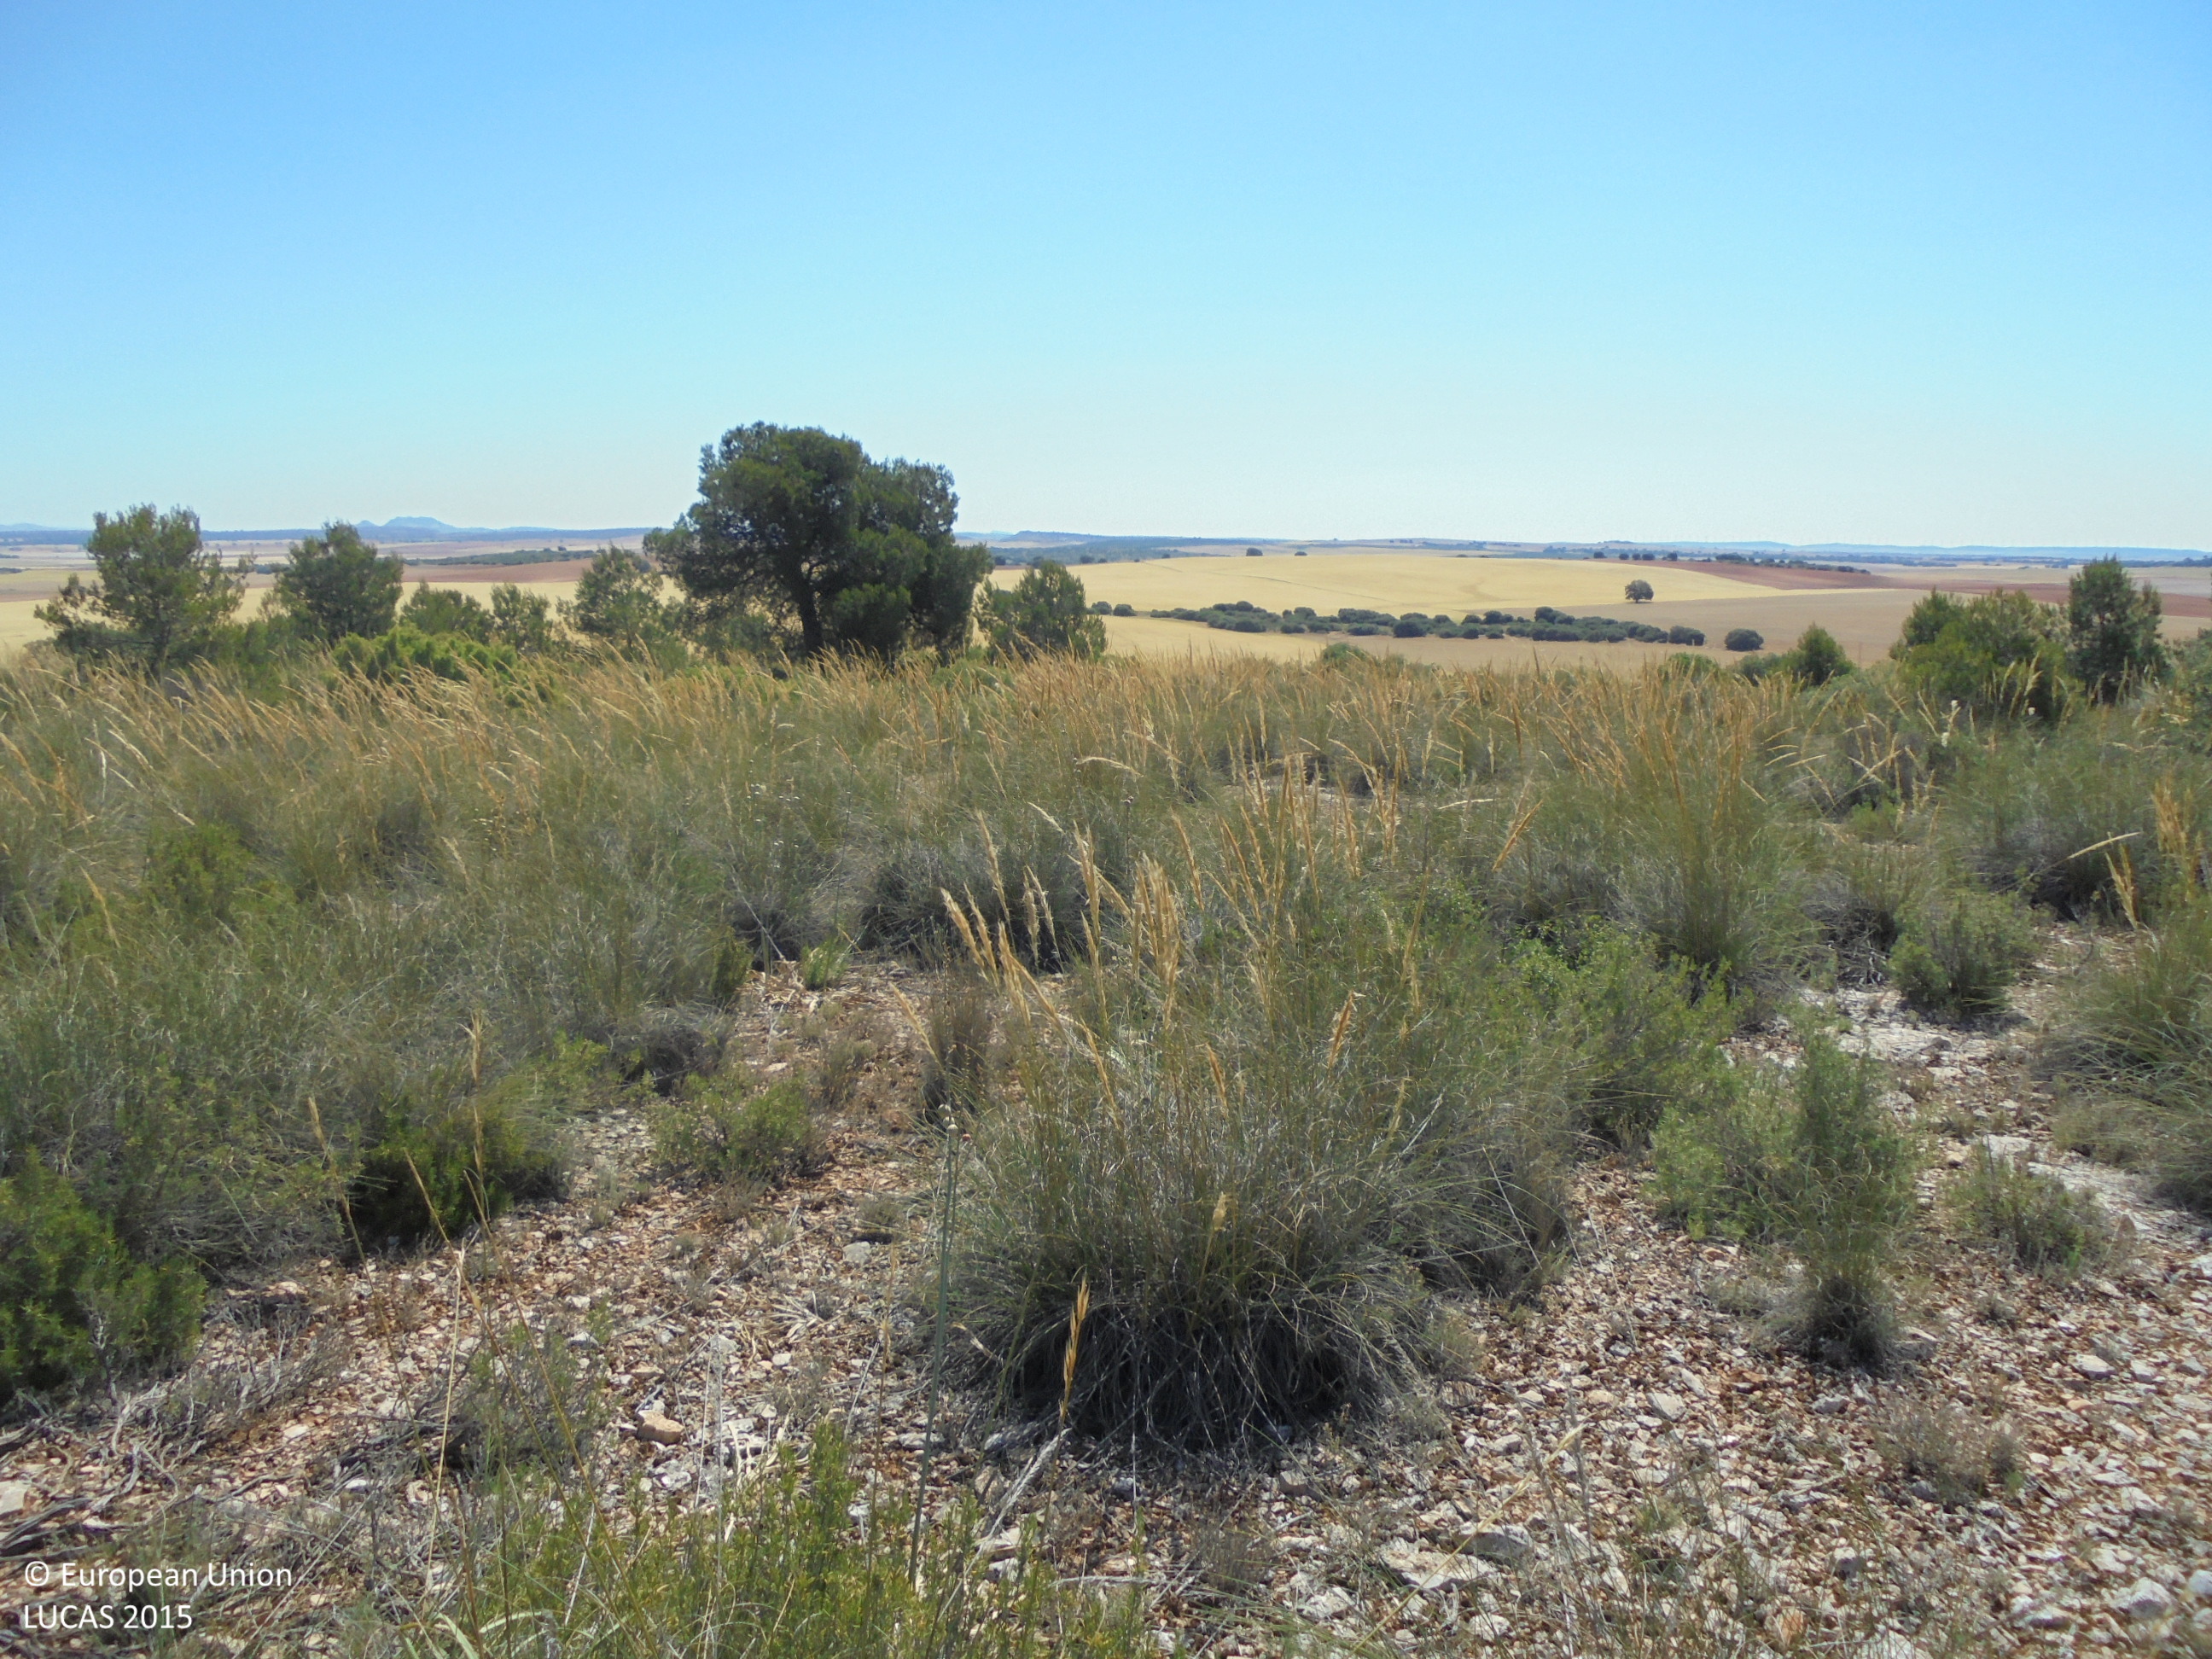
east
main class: Shrubland
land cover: Shrubland without tree cover
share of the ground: 50 - 75 %
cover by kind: shrubs 65 %, unconsolidated bare surface 25 %, consolidated bare surface 10 %
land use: Semi-natural and natural areas not in use
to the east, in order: Shrubland without tree cover; Pine dominated coniferous woodland; Shrubland without tree cover; Barley
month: June
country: ES
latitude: 38.8378
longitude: -1.6674
